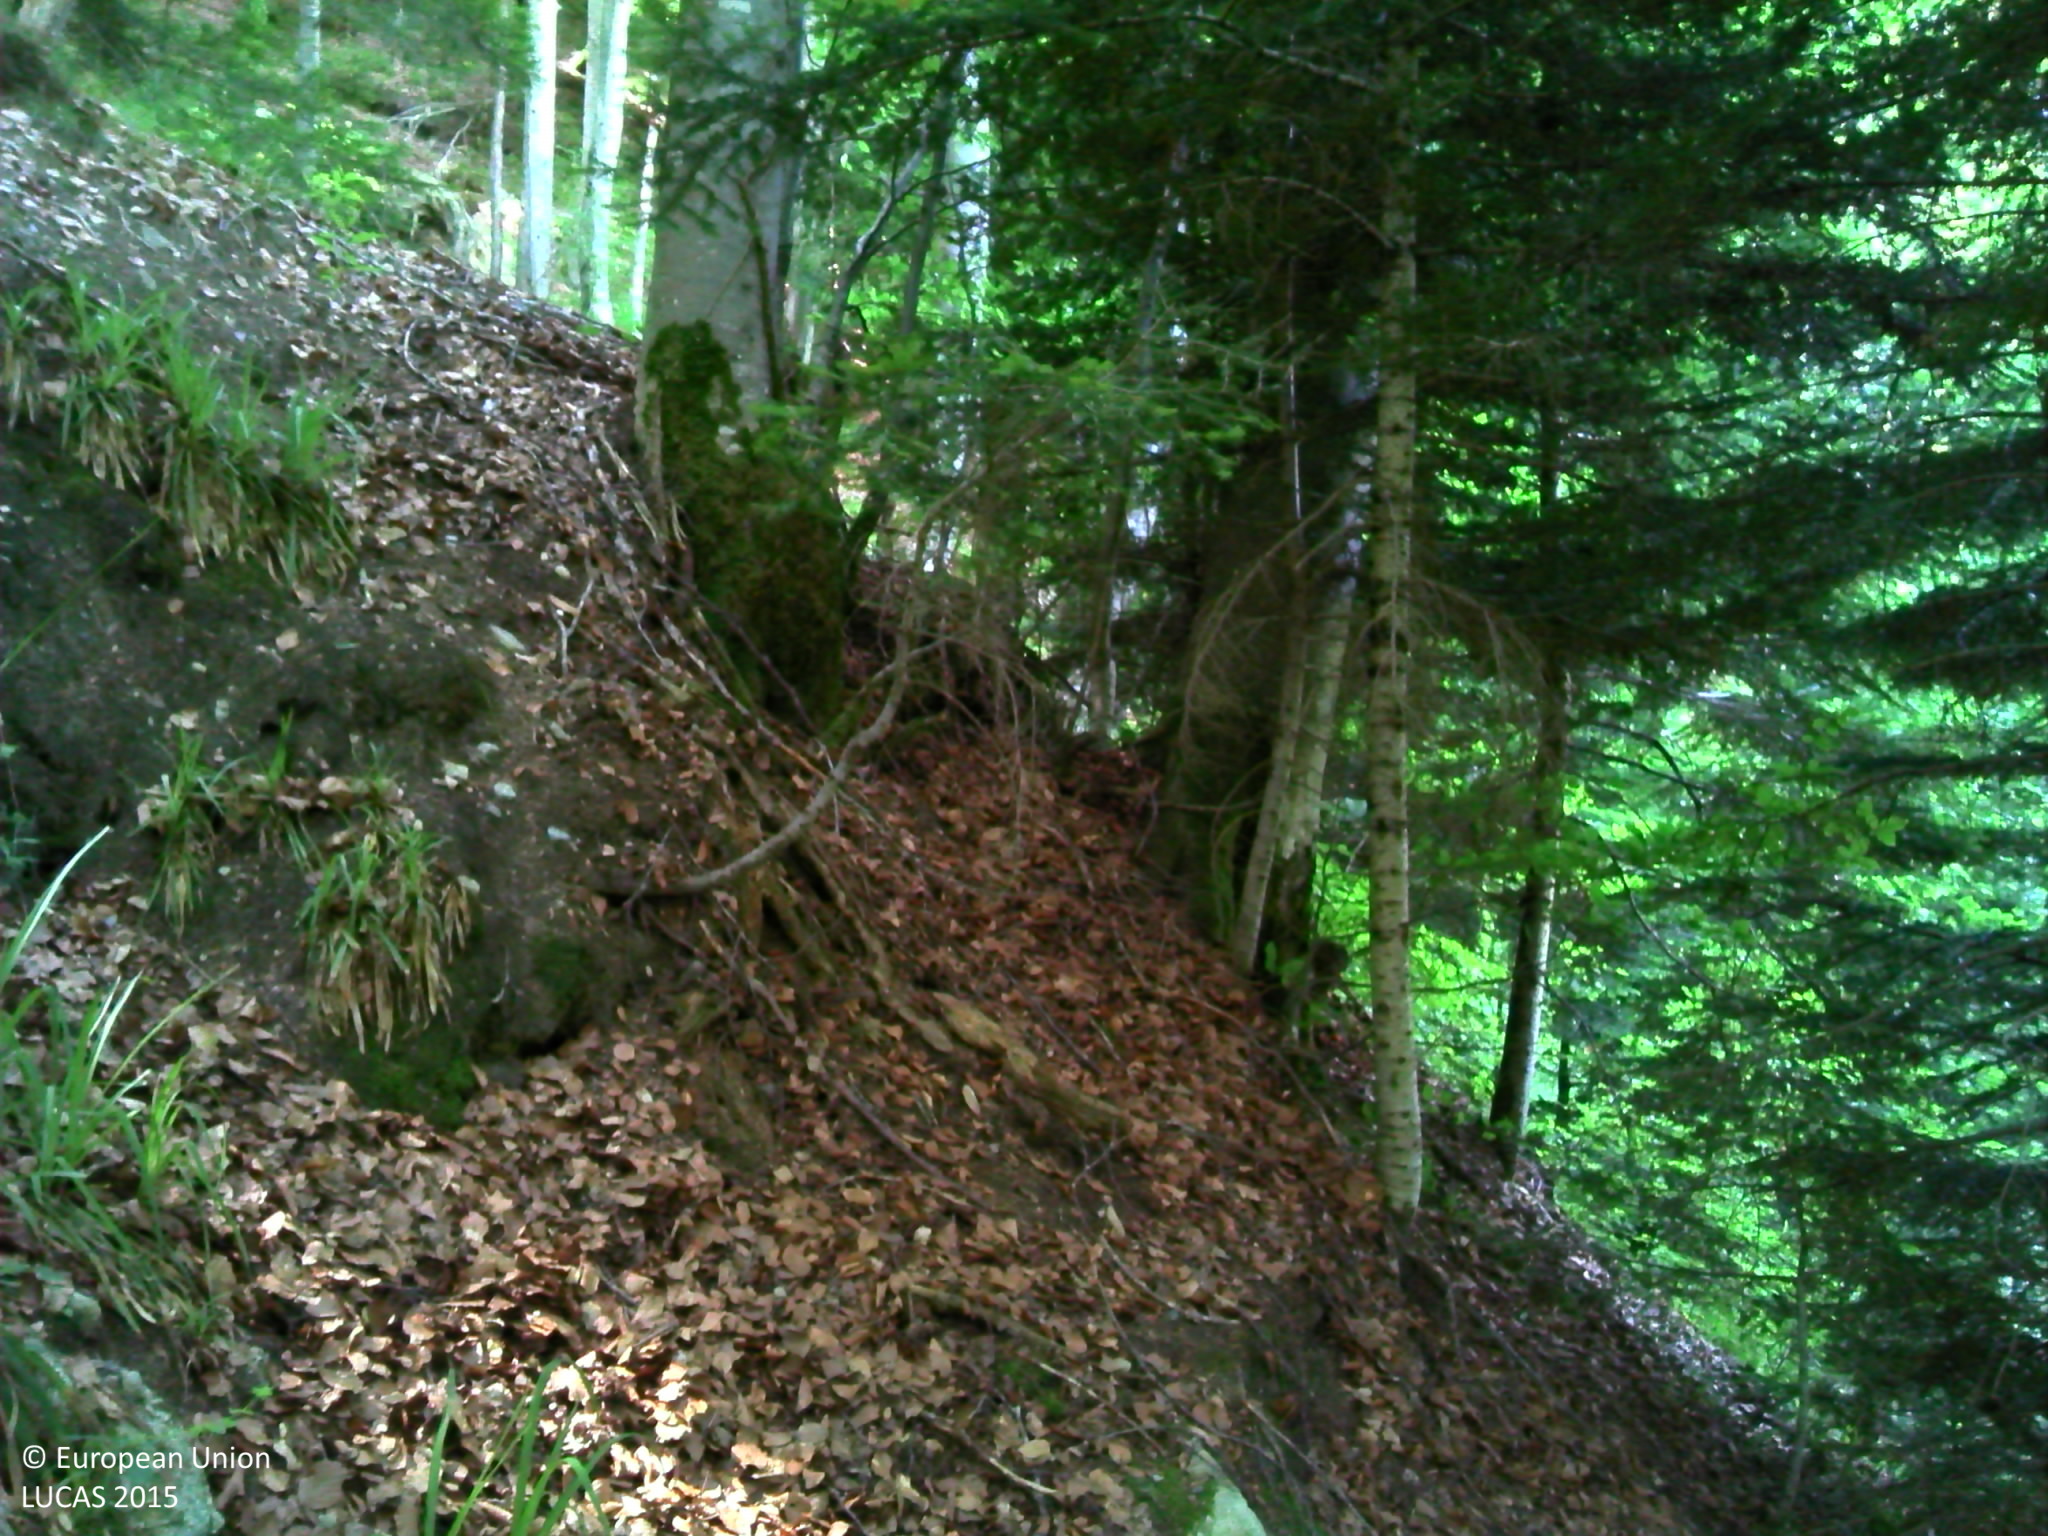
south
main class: Woodland
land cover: Other mixed woodland
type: mountainous beech forest
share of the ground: > 75 %
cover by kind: broadleaved forest trees 75 %, coniferous forest trees 25 %
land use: Forestry
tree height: > 5 m
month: July
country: FR
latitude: 42.8930
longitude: -0.1044
